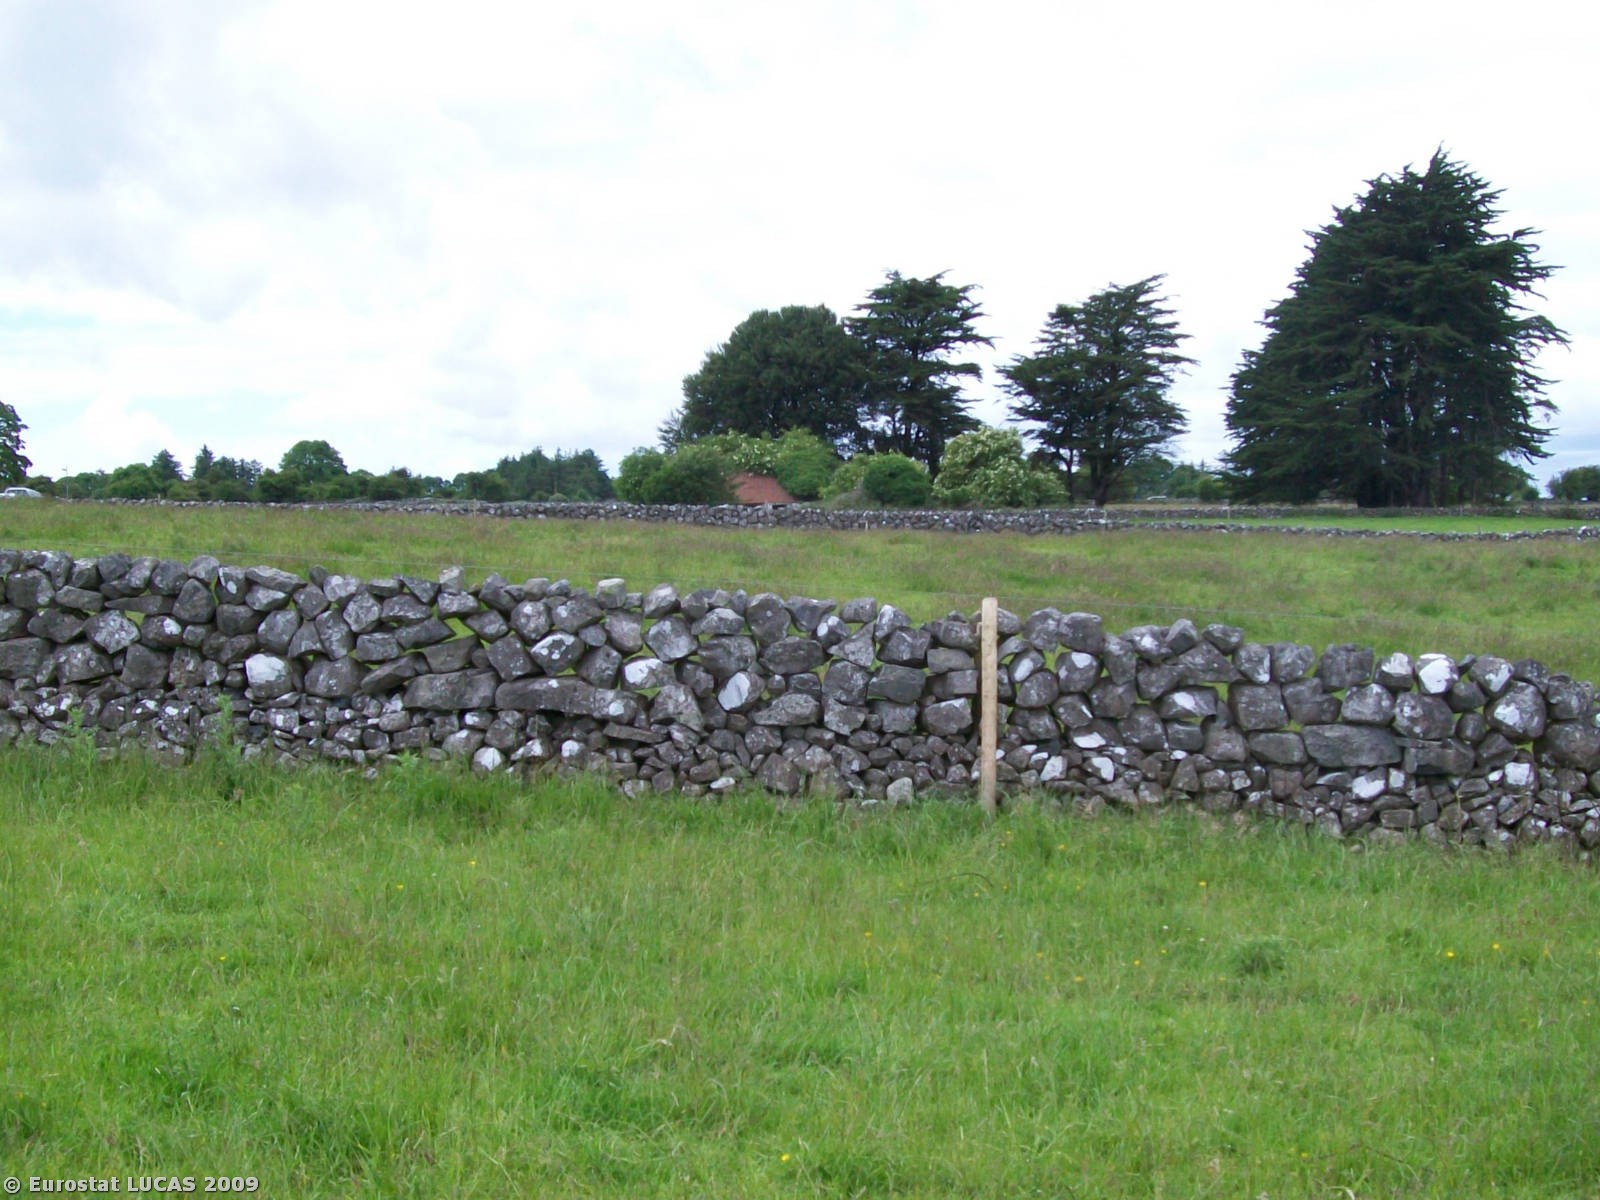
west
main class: Grassland
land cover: Grassland without tree/shrub cover
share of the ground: > 75 %
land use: Agriculture (excluding fallow land and kitchen gardens)
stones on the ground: < 10 %
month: June
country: IE
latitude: 53.3366
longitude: -8.7810
